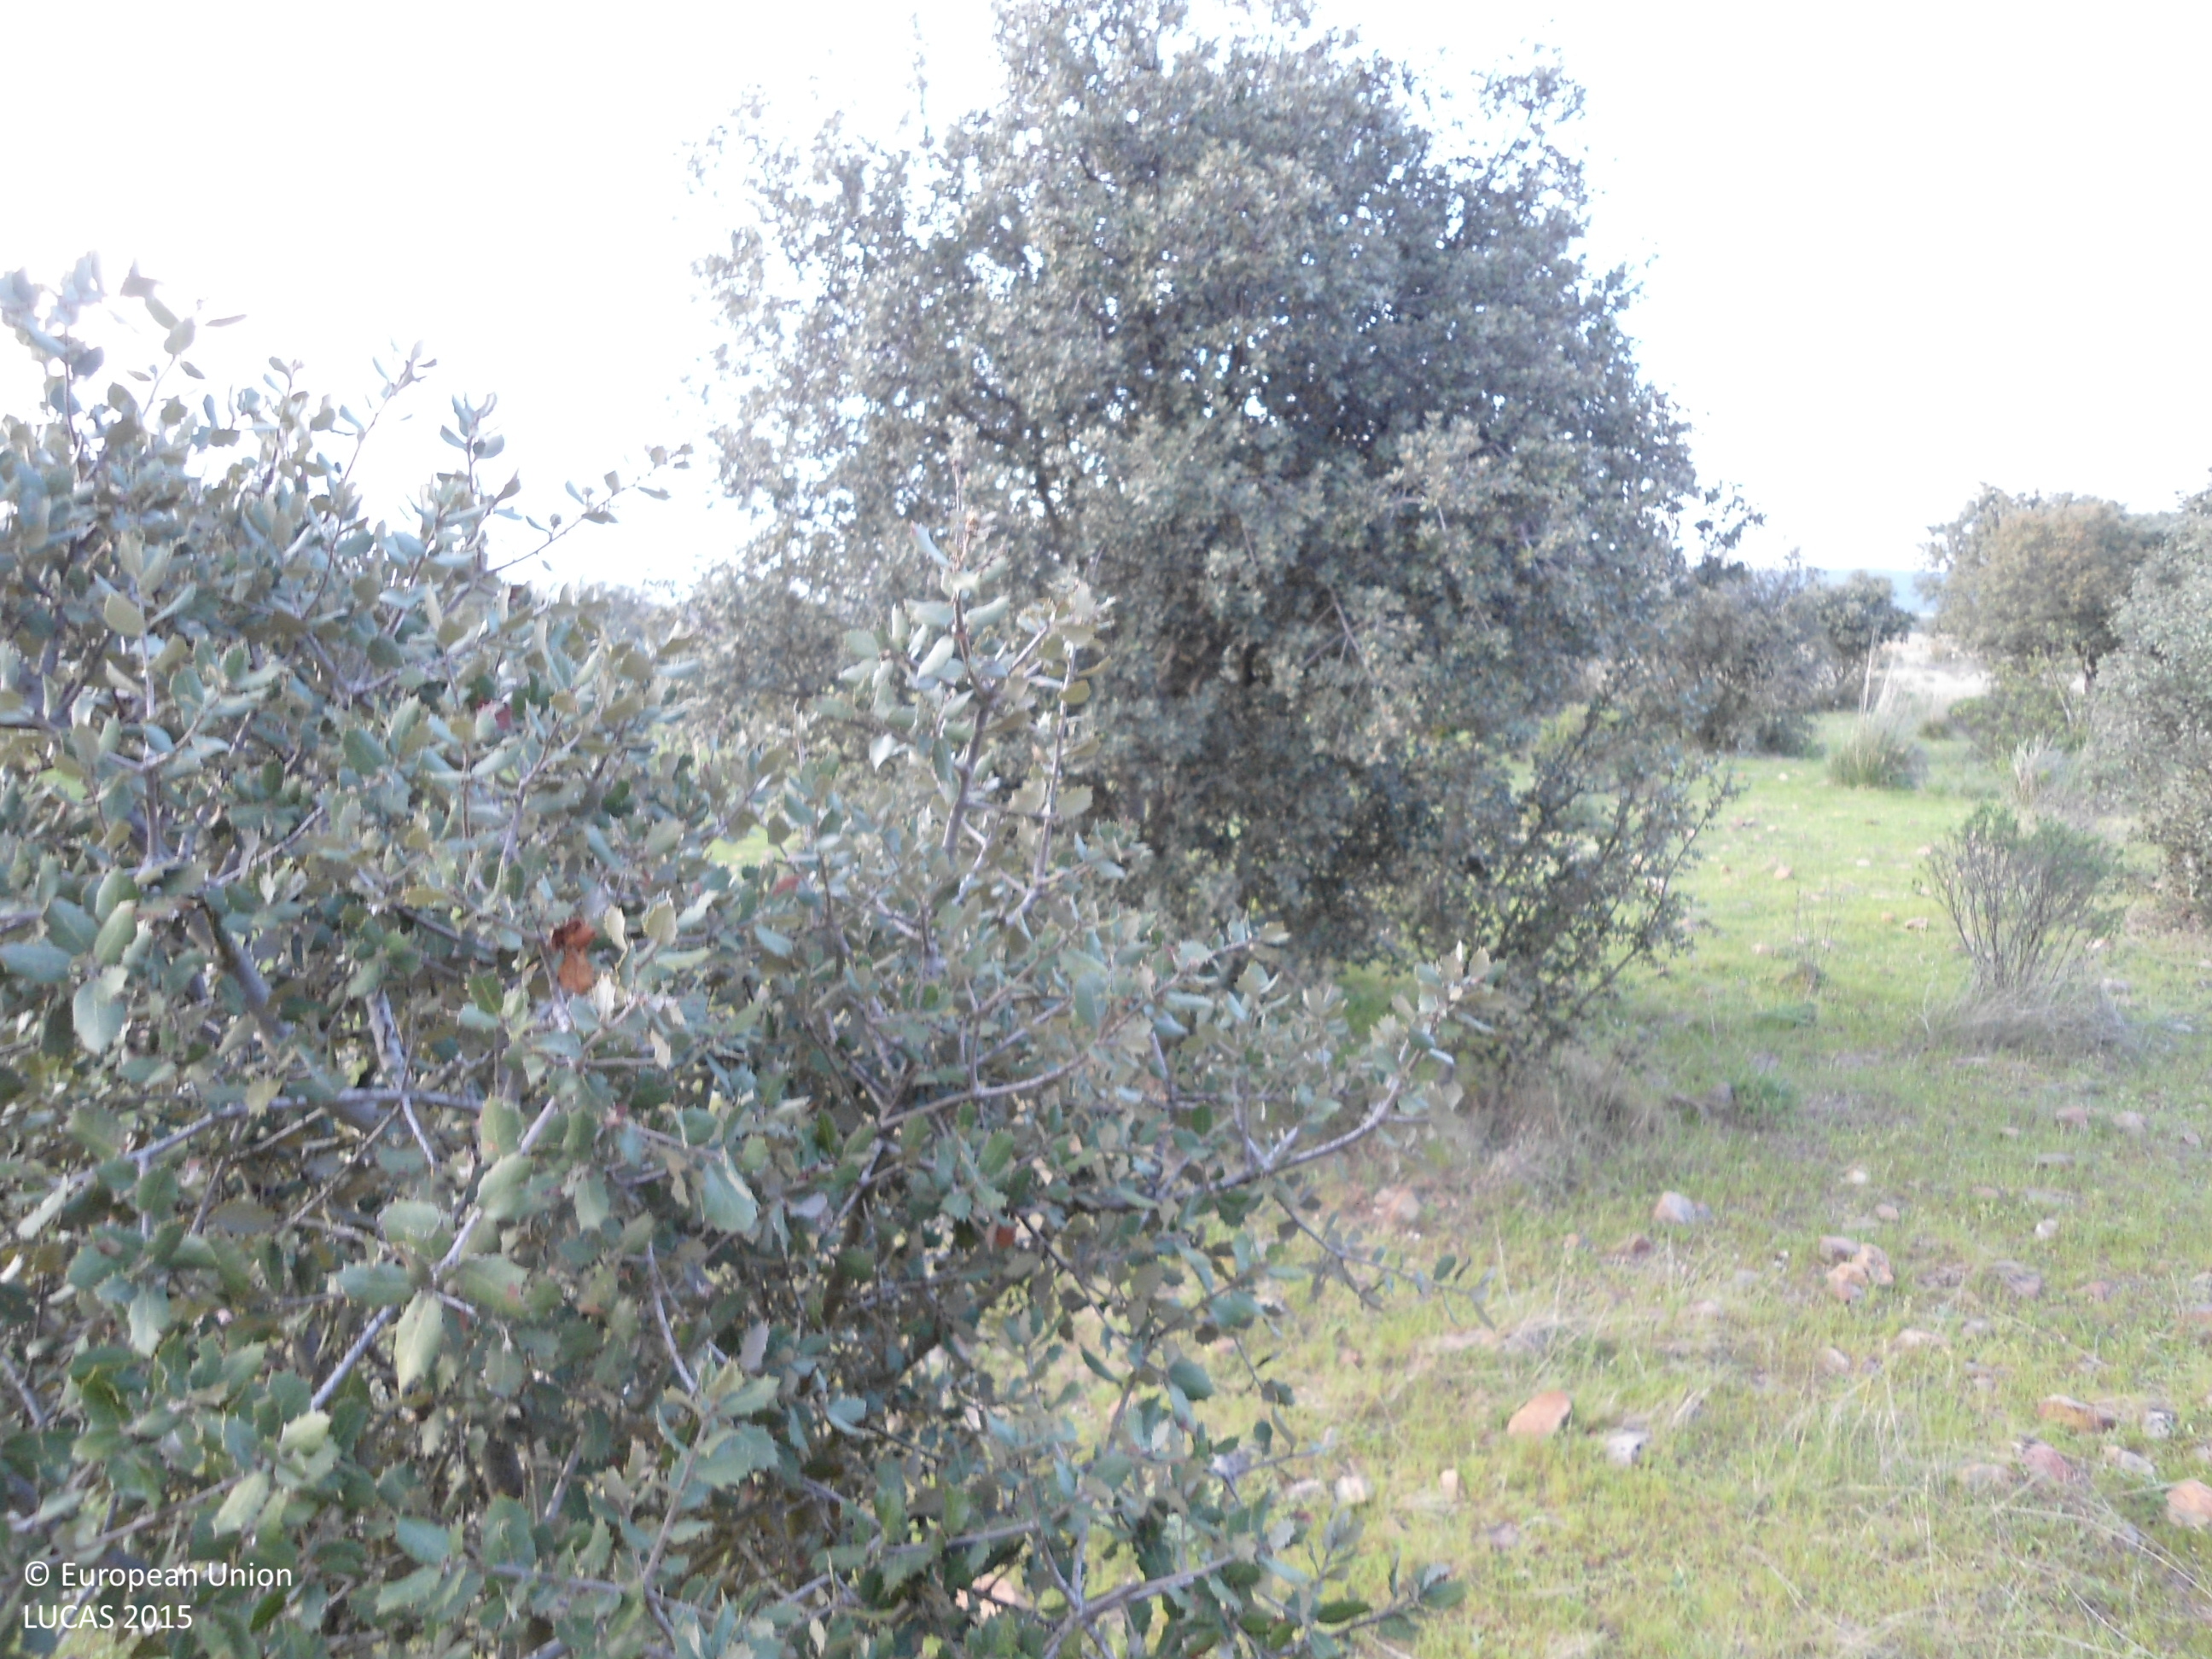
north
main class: Shrubland
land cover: Shrubland with sparse tree cover
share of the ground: > 75 %
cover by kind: shrubs 75 %, herbaceous plants 20 %, broadleaved forest trees 5 %
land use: Agriculture (excluding fallow land and kitchen gardens)
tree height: < 5 m
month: April
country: ES
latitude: 41.8000
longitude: -5.9696
